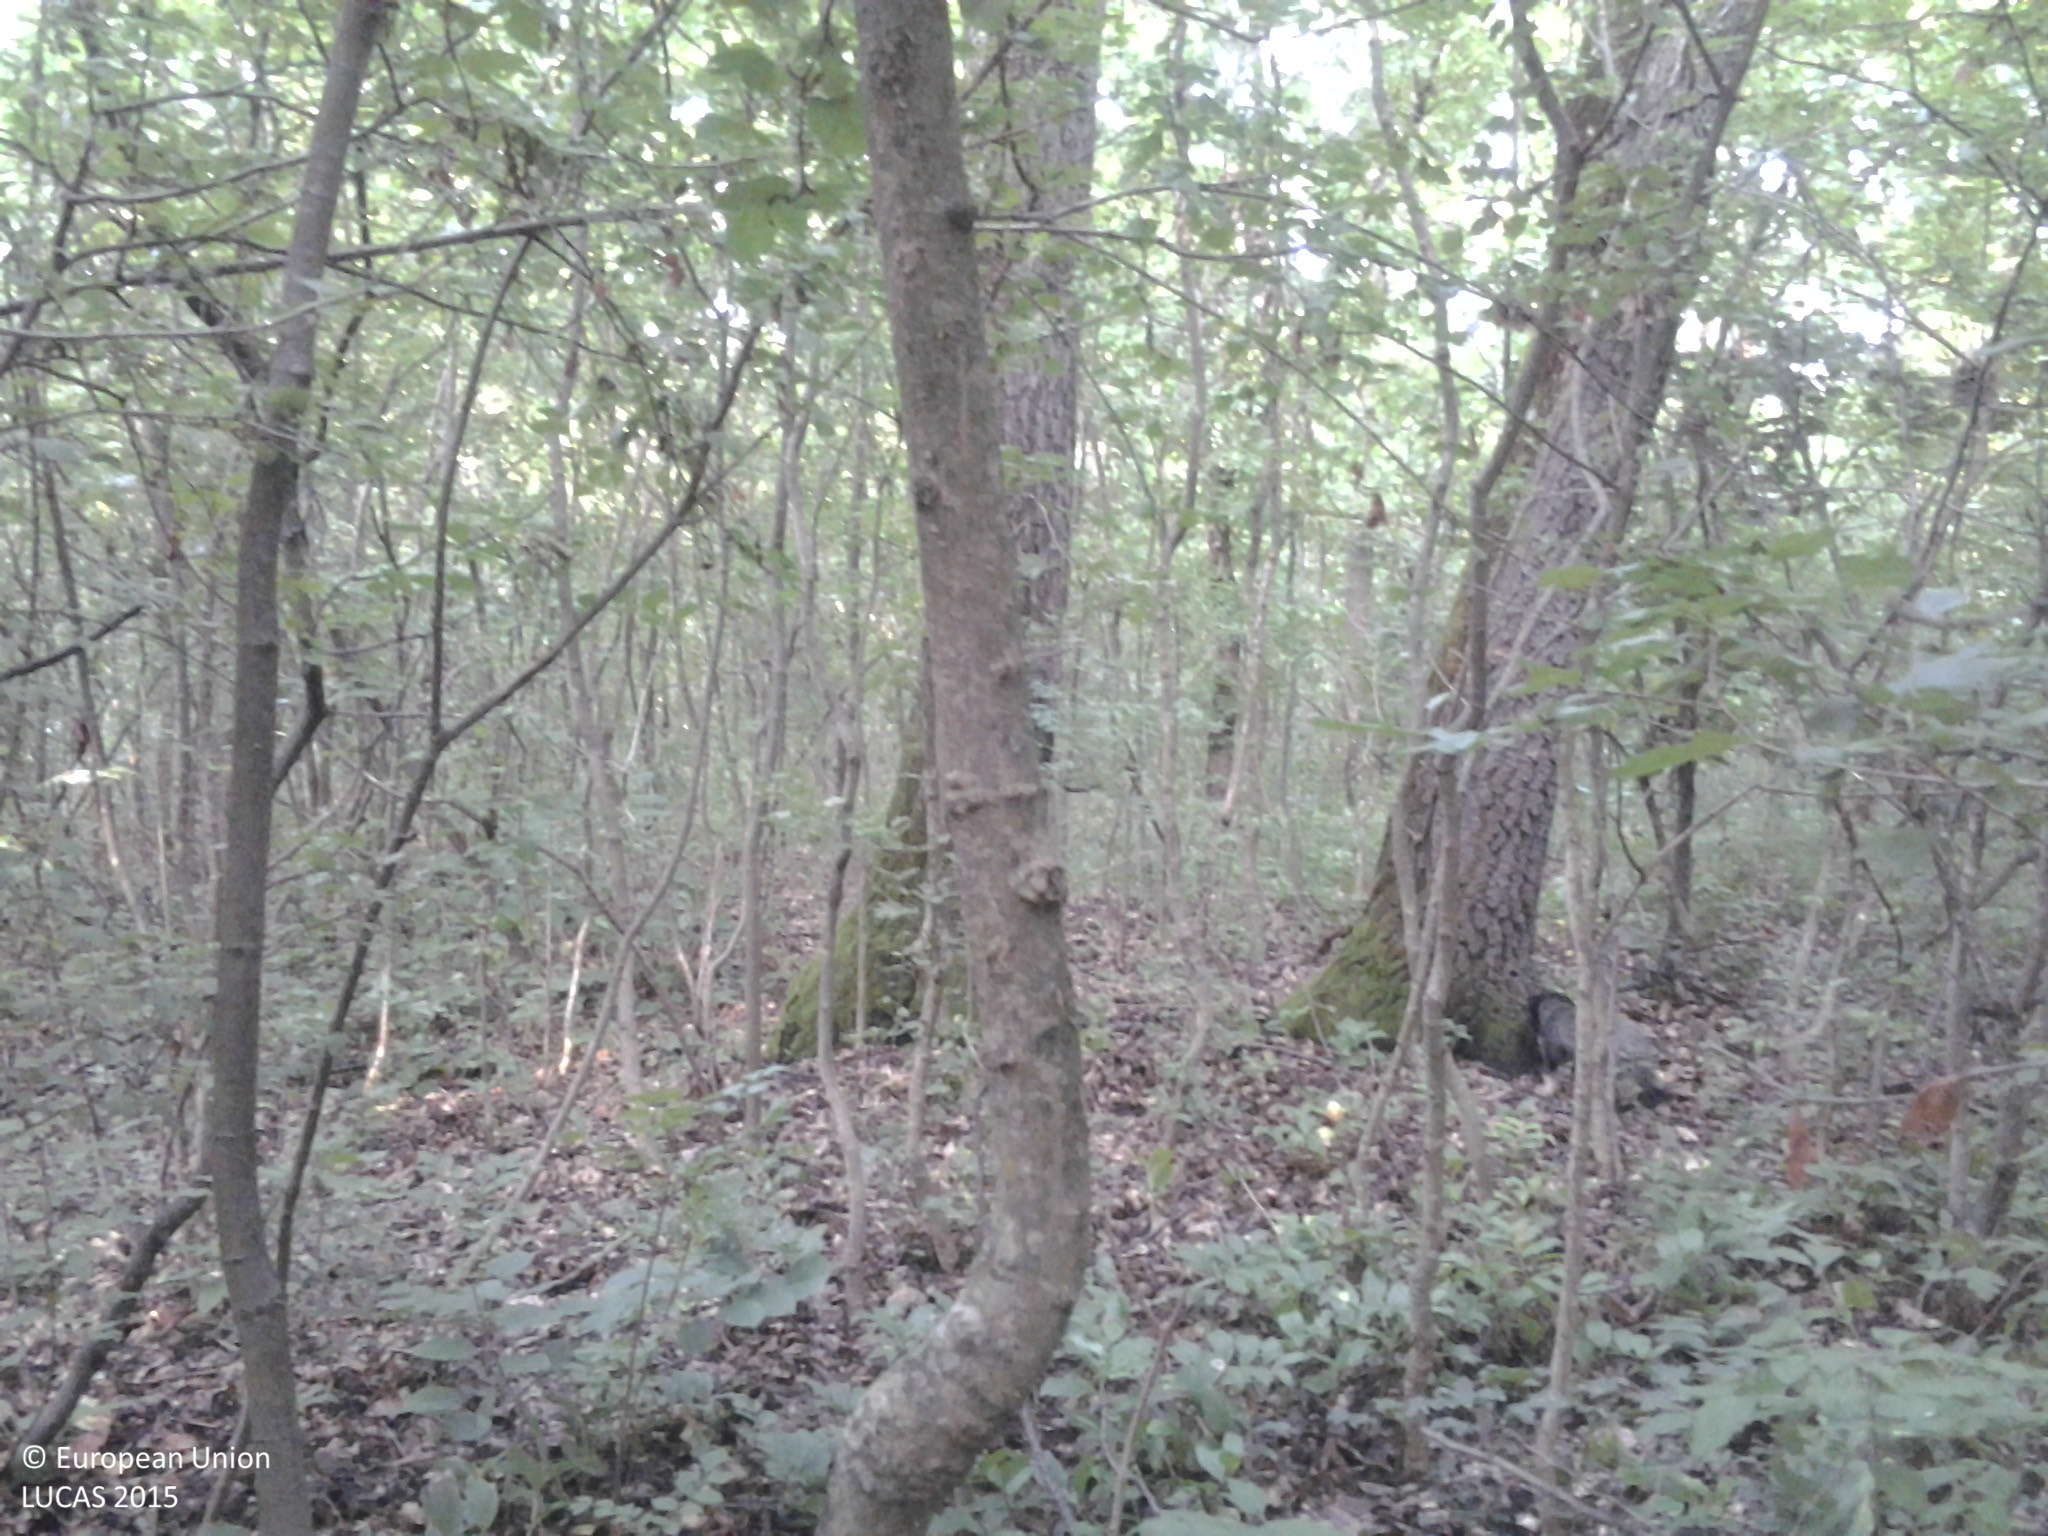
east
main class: Woodland
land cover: Broadleaved woodland
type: mesophytic deciduous forest
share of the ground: > 75 %
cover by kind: broadleaved forest trees 100 %
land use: Forestry
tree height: > 5 m
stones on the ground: 10 - 25 %
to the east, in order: Broadleaved woodland; Grassland with sparse tree/shrub cover; Railways; Broadleaved woodland; Inland marshes; Broadleaved woodland
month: June
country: RO
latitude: 44.1595
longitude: 26.1465
